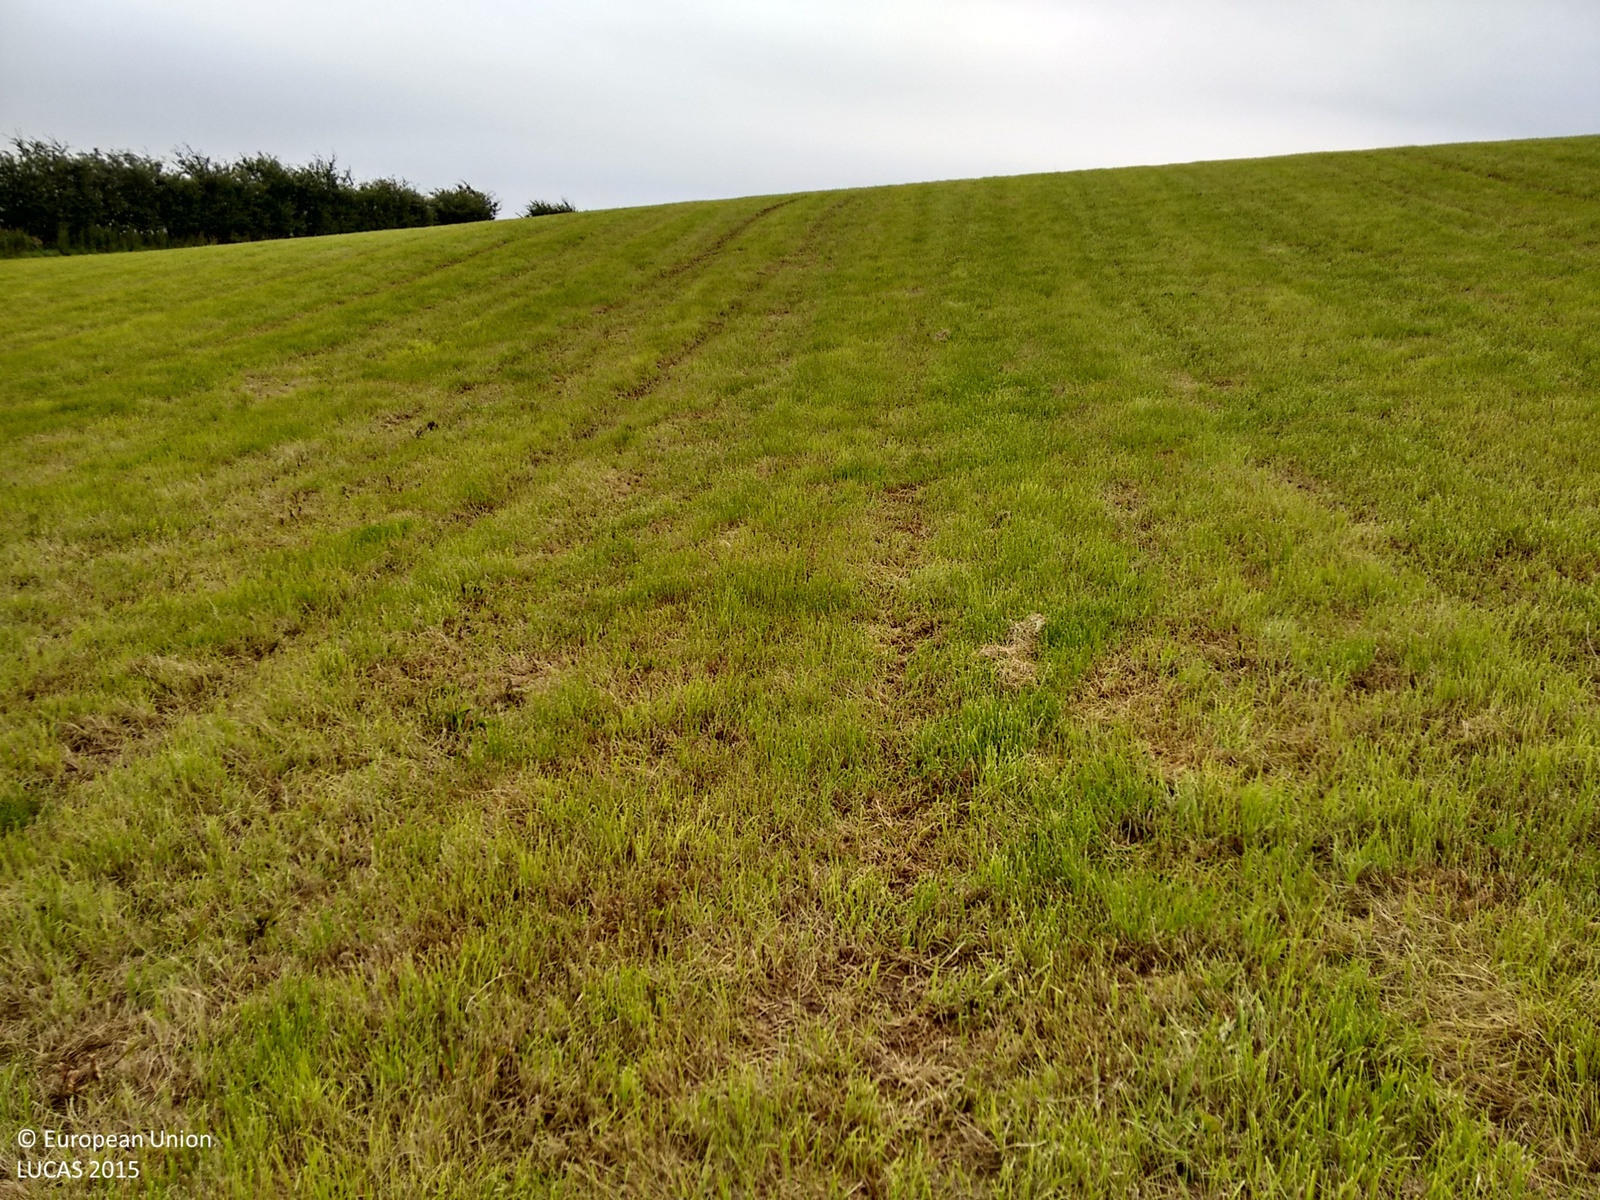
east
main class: Grassland
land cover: Grassland without tree/shrub cover
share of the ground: > 75 %
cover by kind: herbaceous plants 80 %, unconsolidated bare surface 20 %
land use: Agriculture (excluding fallow land and kitchen gardens)
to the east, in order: Grassland without tree/shrub cover; Fences; Managed hedges; Grass margins; Tracks; Grass margins; Managed hedges; Fences; Grassland without tree/shrub cover
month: August
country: GB
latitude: 55.1553
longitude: -3.3702
